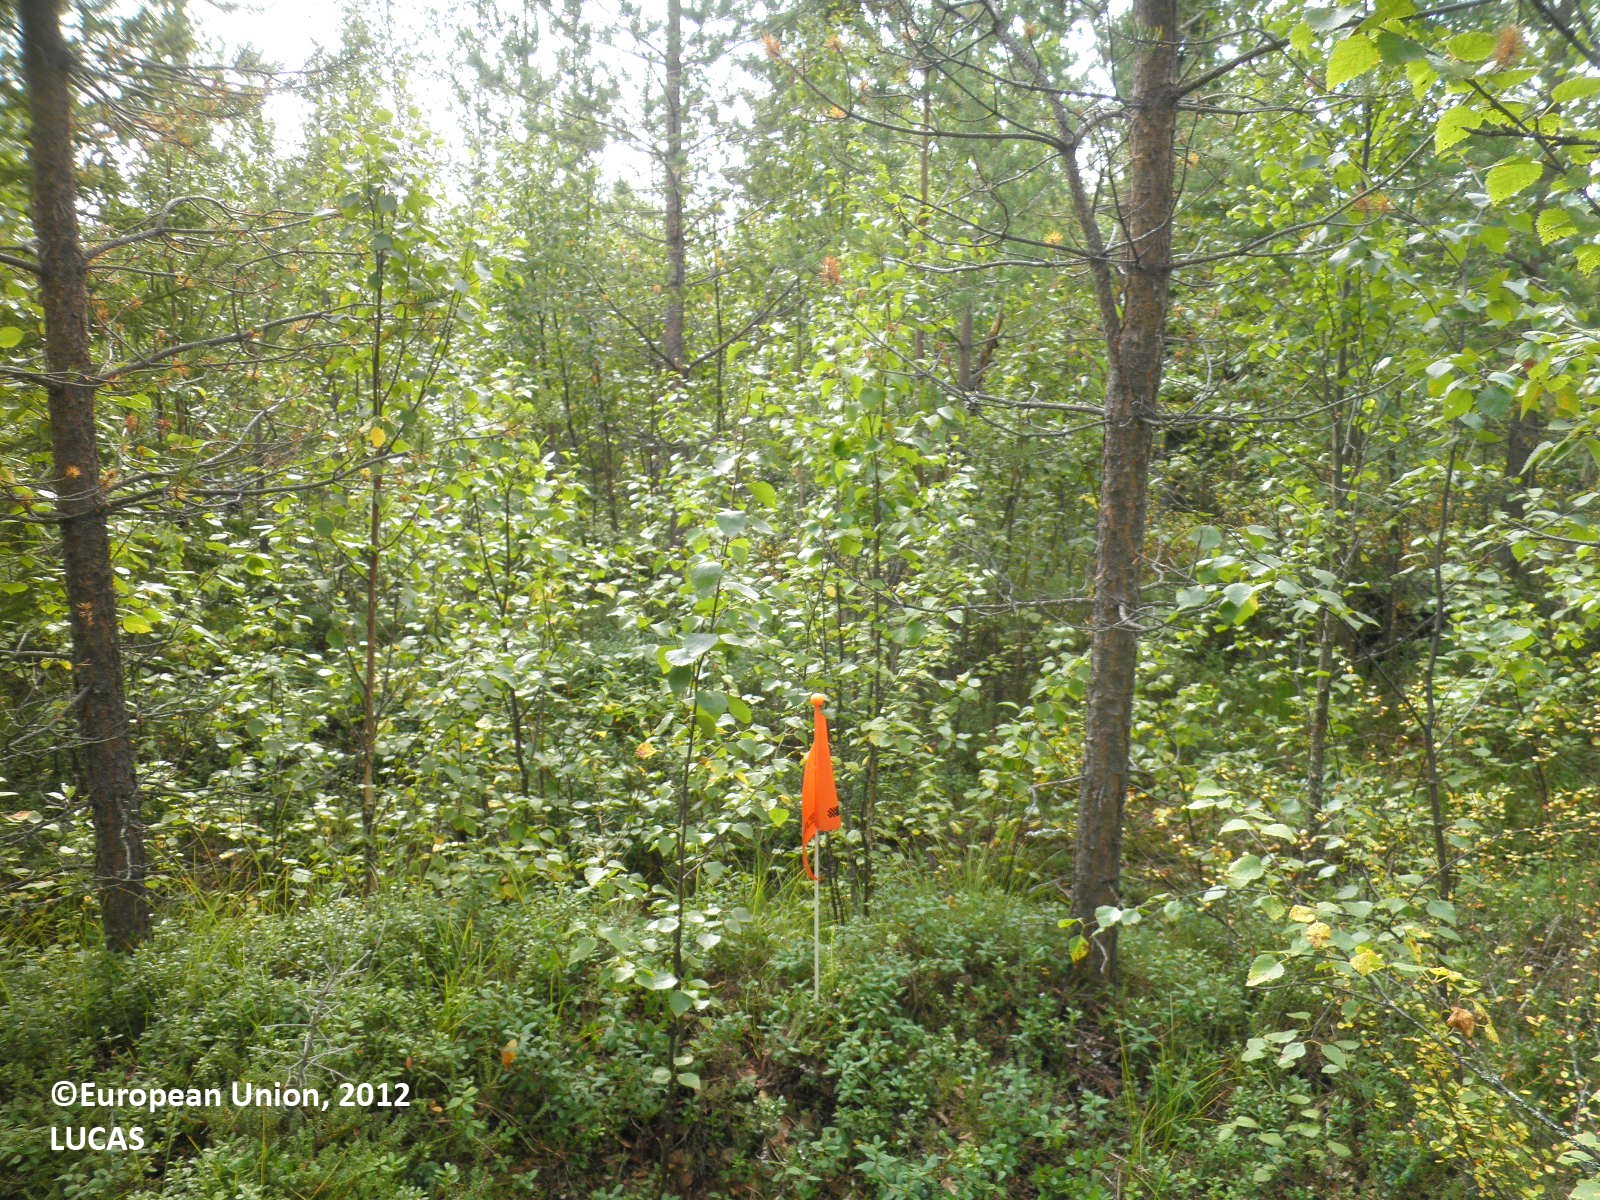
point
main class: Woodland
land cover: Pine dominated mixed woodland
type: boreal forest
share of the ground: 50 - 75 %
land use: Forestry
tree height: > 5 m
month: August
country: FI
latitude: 67.5387
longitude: 27.0903
